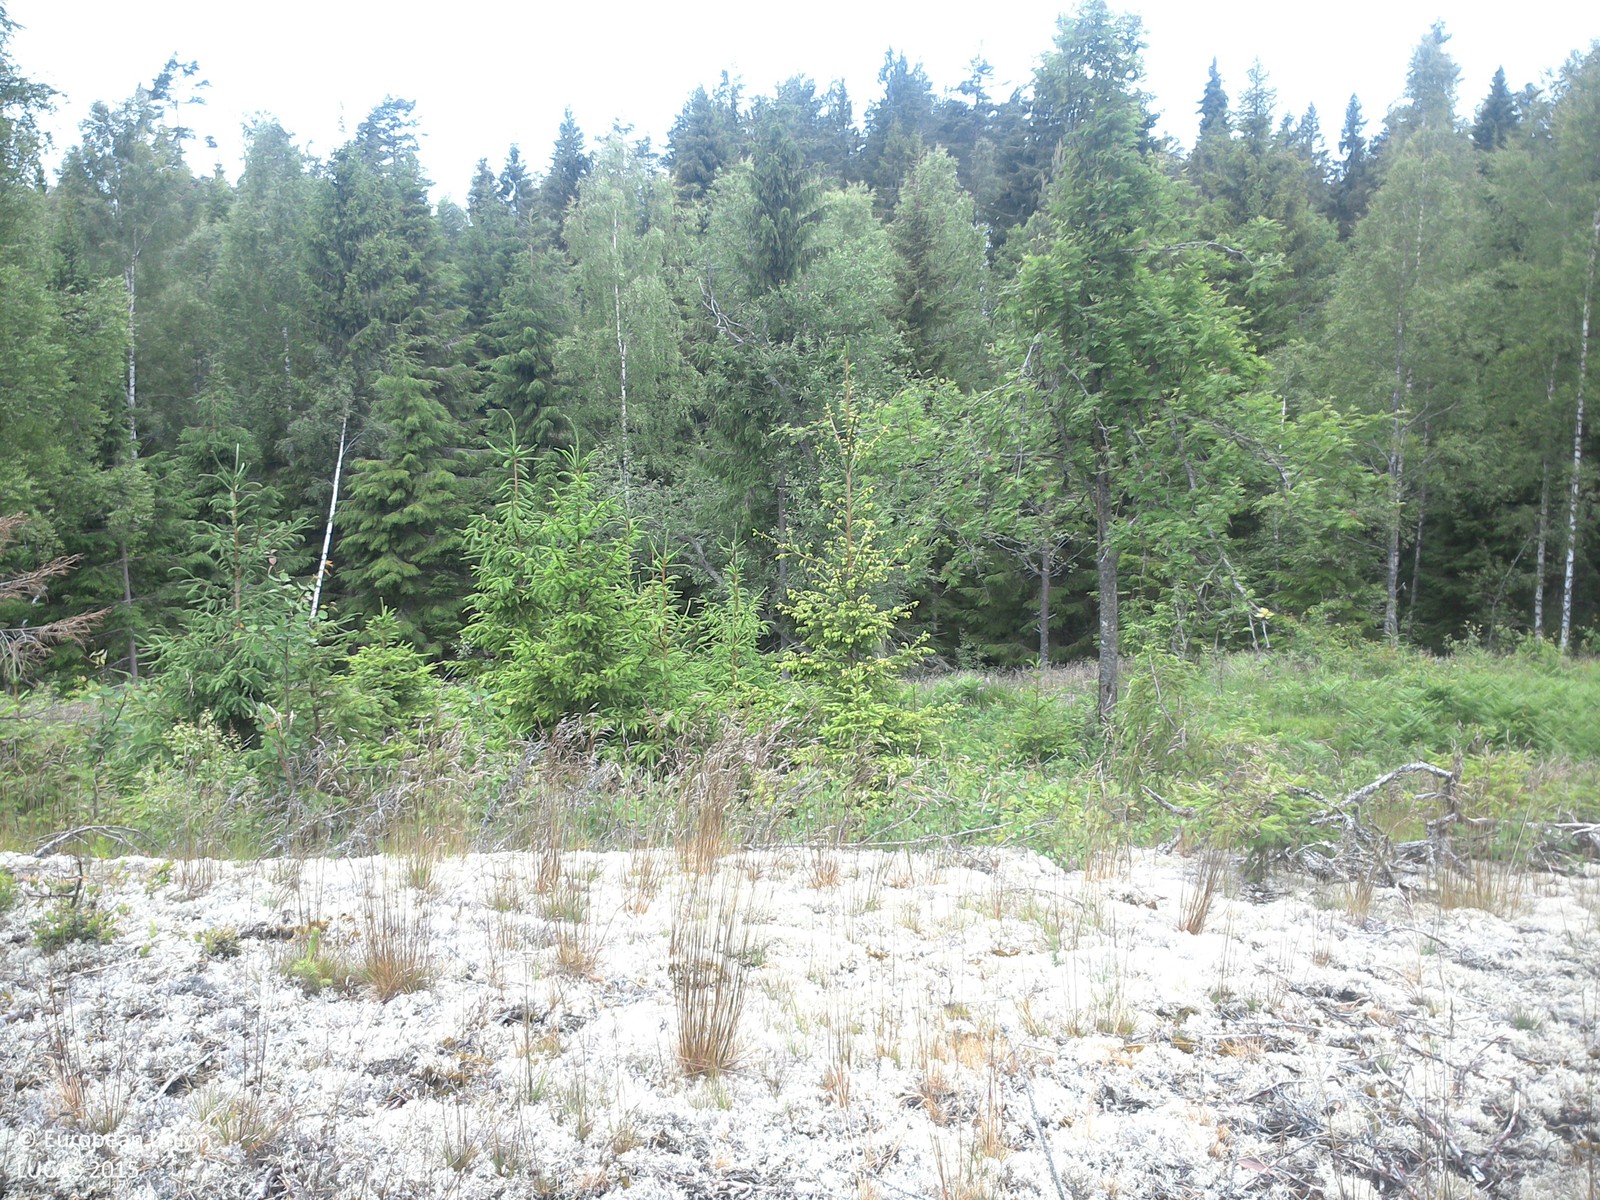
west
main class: Woodland
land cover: Pine dominated coniferous woodland
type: boreal forest
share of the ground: 10 - 25 %
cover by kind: herbaceous plants 45 %, lichens and mosses 40 %, coniferous forest trees 15 %
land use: Forestry
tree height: > 5 m
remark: Clear cut
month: June
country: SE
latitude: 58.1452
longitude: 15.4482
